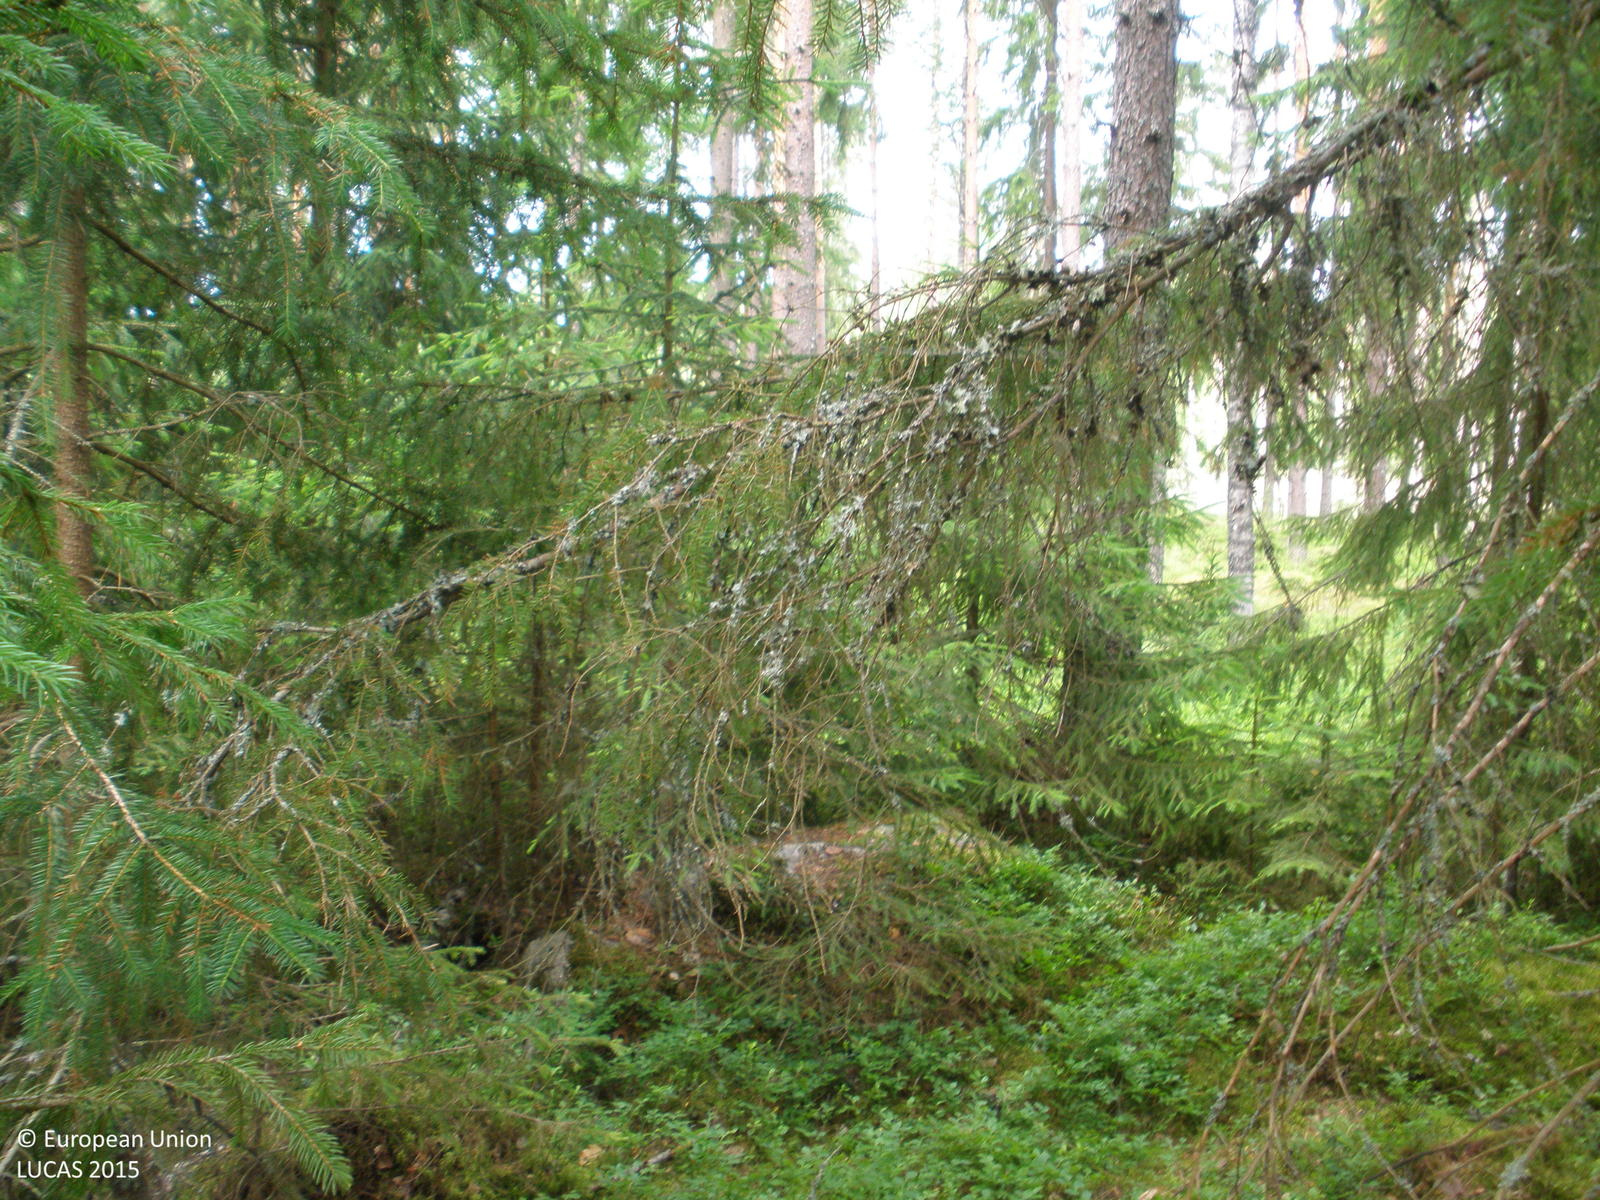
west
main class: Woodland
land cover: Other coniferous woodland
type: boreal forest
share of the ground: > 75 %
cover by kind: coniferous forest trees 70 %, broadleaved forest trees 15 %, lichens and mosses 10 %, herbaceous plants 5 %
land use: Forestry
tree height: > 5 m
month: July
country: FI
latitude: 60.9083
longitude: 23.2252
